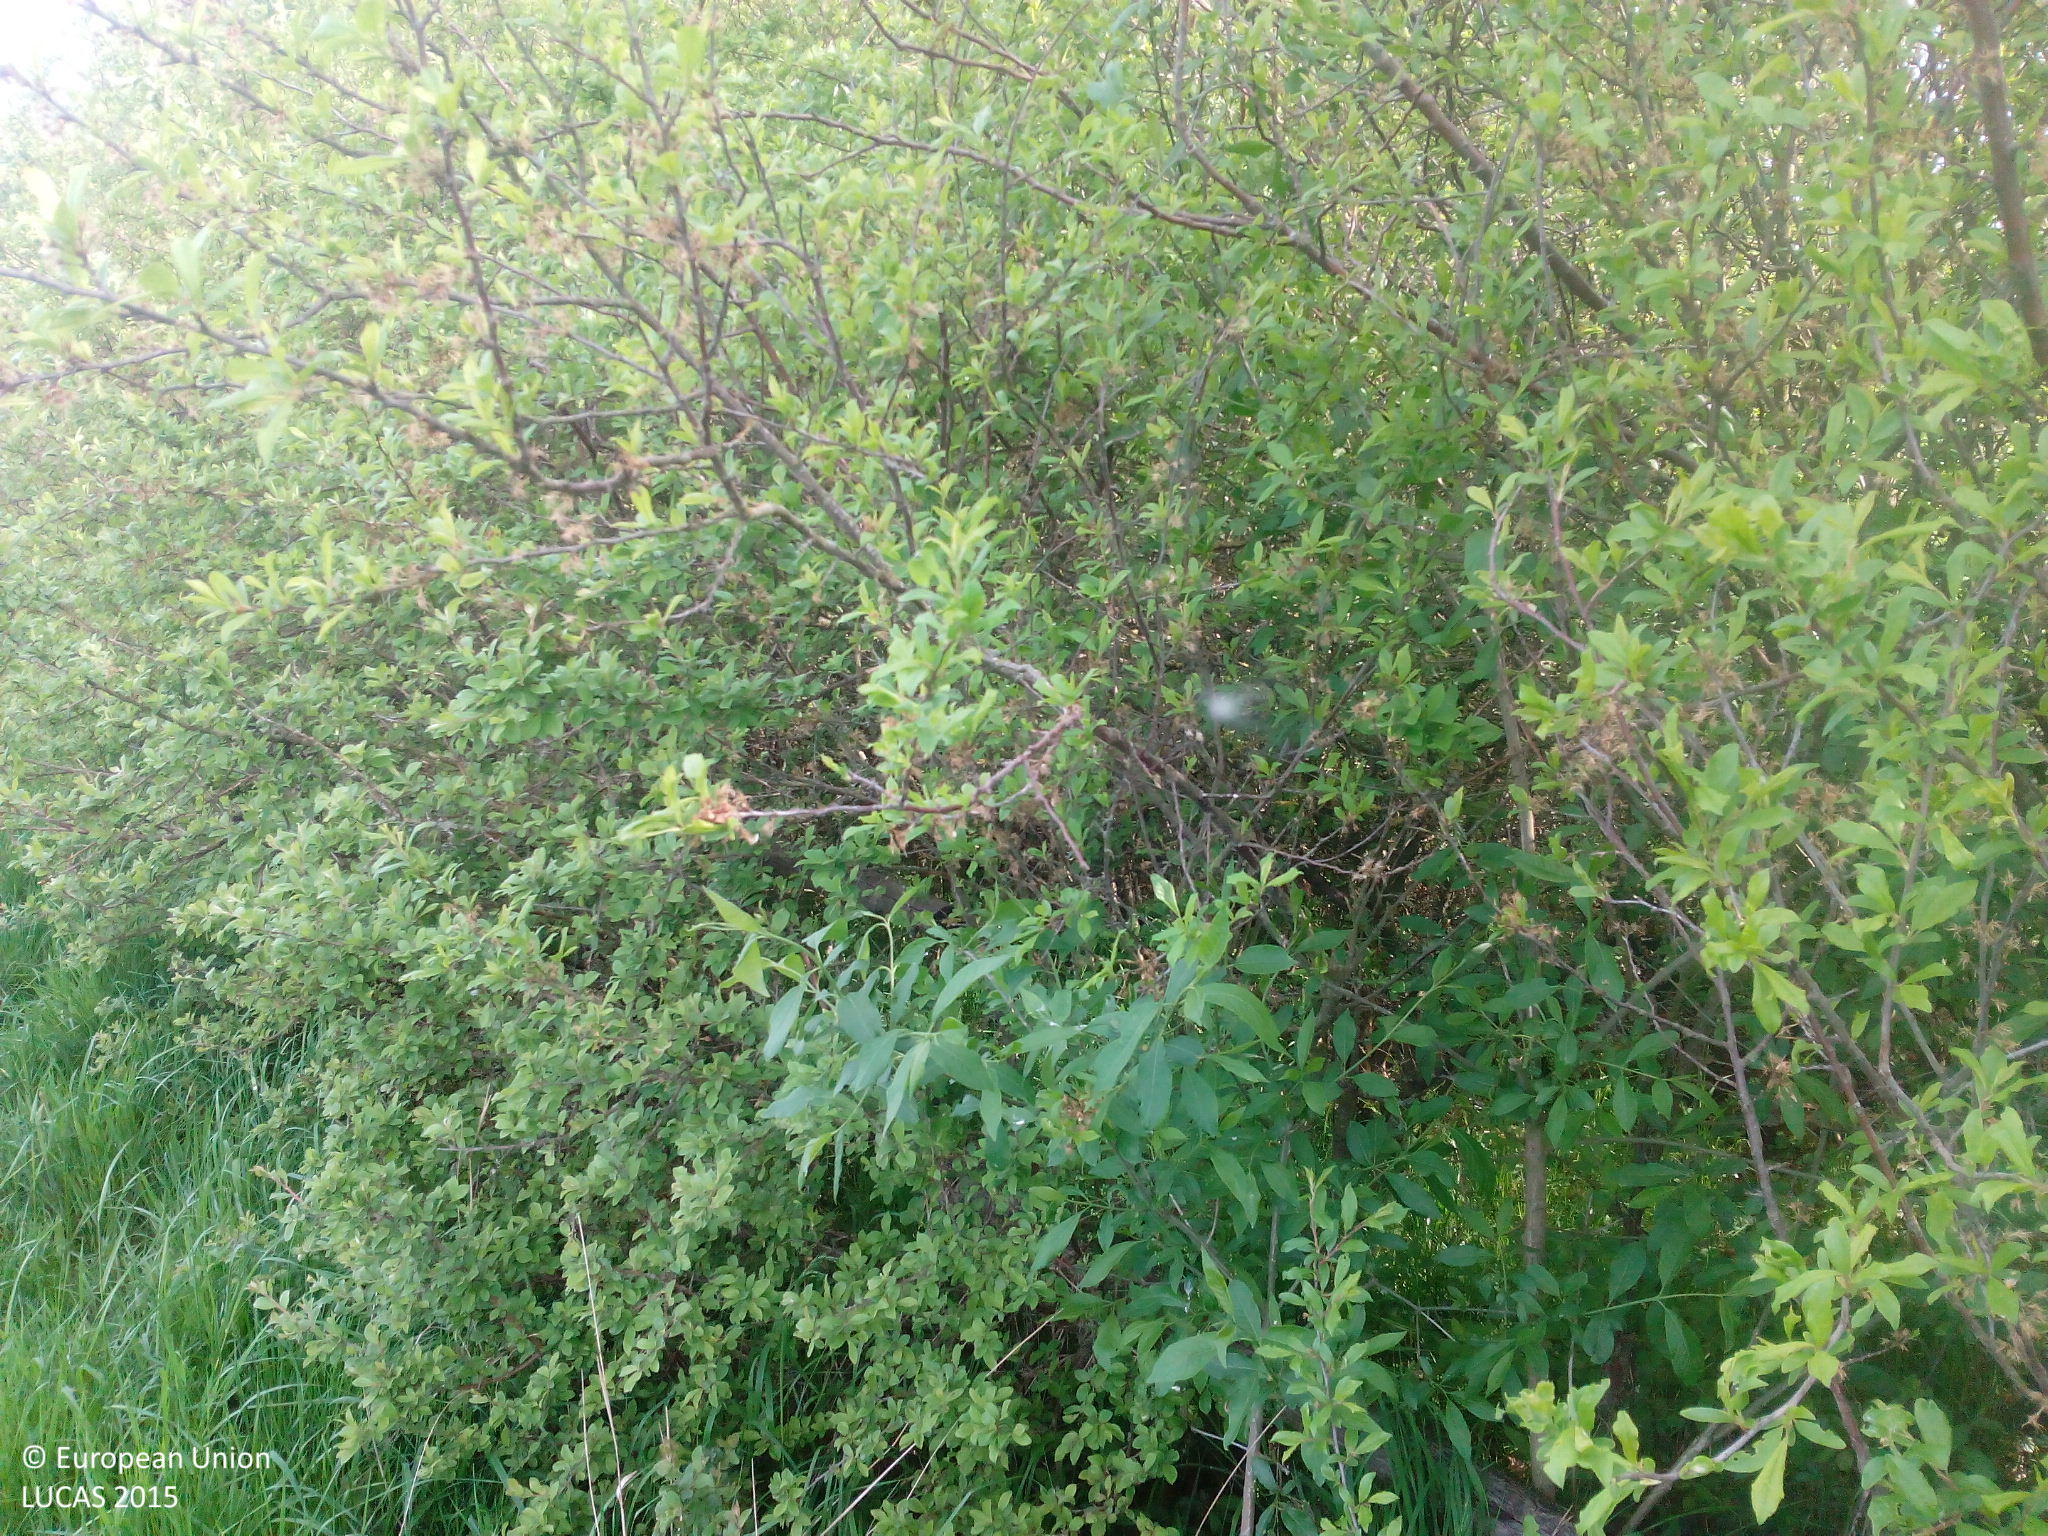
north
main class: Shrubland
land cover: Shrubland with sparse tree cover
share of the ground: > 75 %
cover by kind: shrubs 95 %, broadleaved forest trees 5 %
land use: Semi-natural and natural areas not in use
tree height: < 5 m
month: May
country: DE
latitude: 49.9227
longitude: 11.4900
